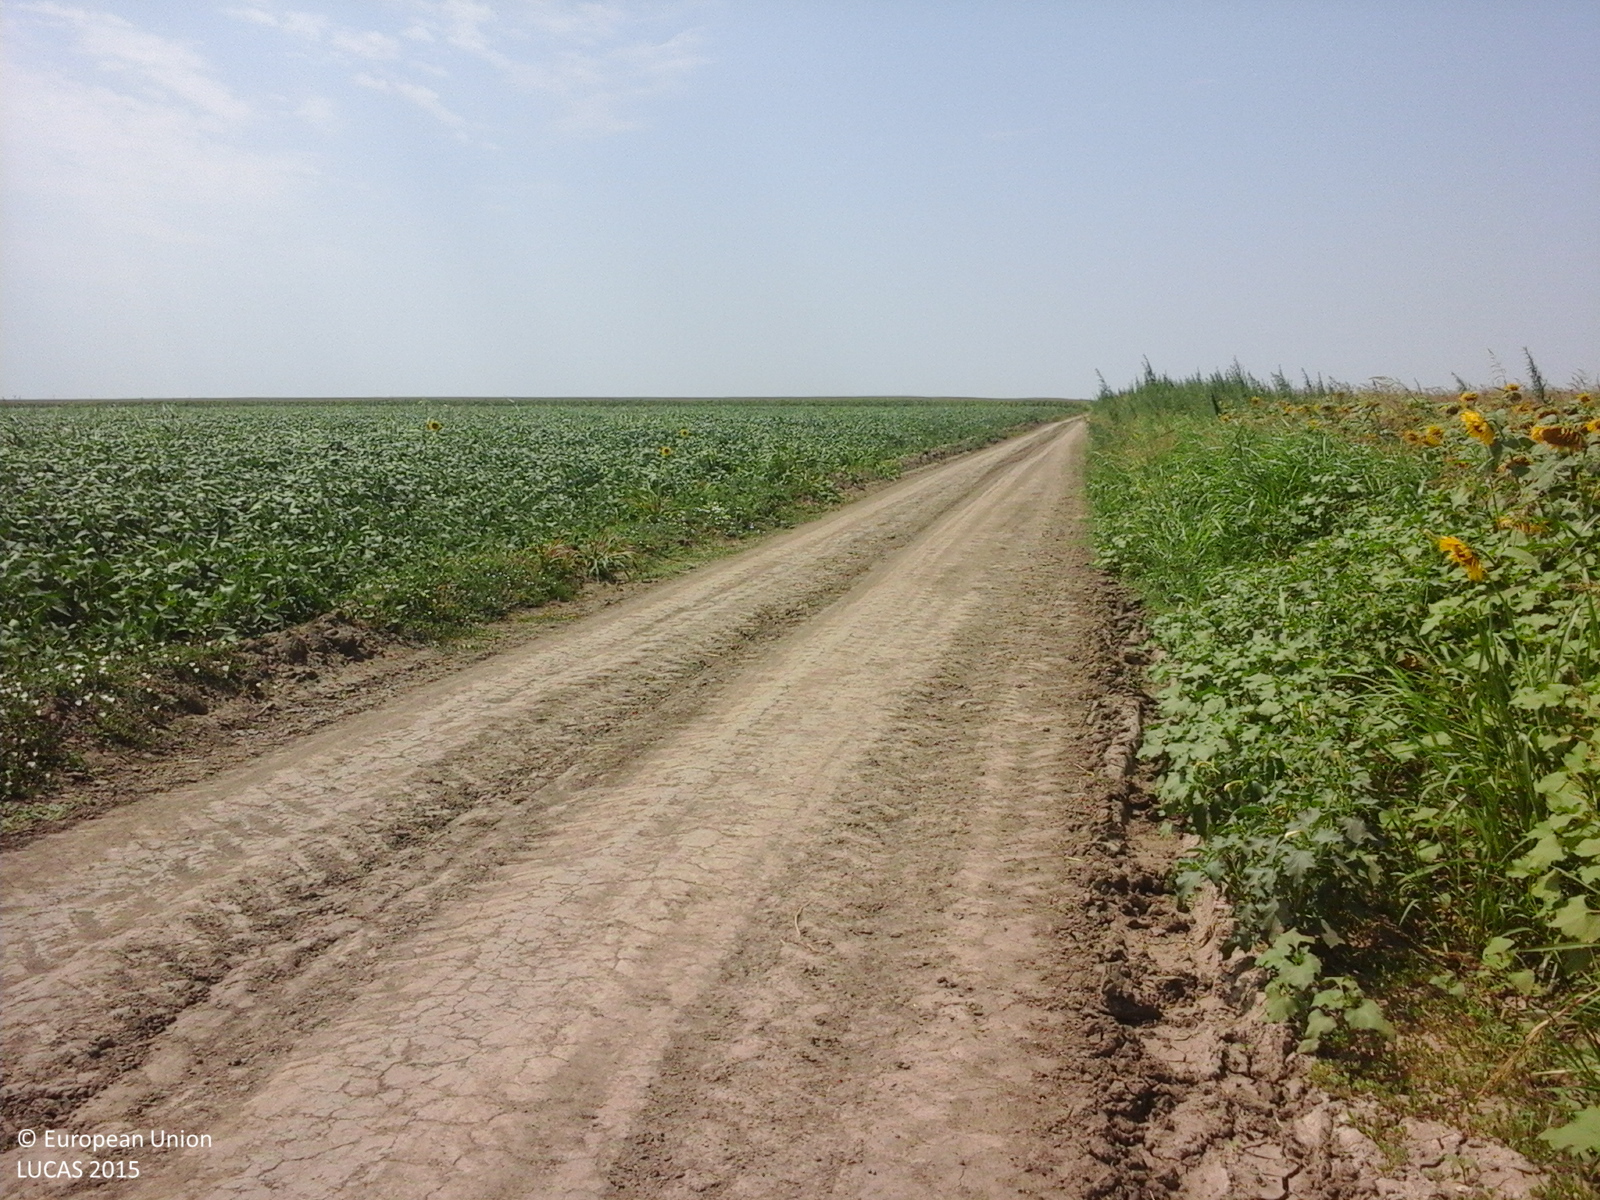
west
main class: Cropland
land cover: Sunflower
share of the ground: > 75 %
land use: Agriculture (excluding fallow land and kitchen gardens)
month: July
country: RO
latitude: 44.7054
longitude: 27.5256
